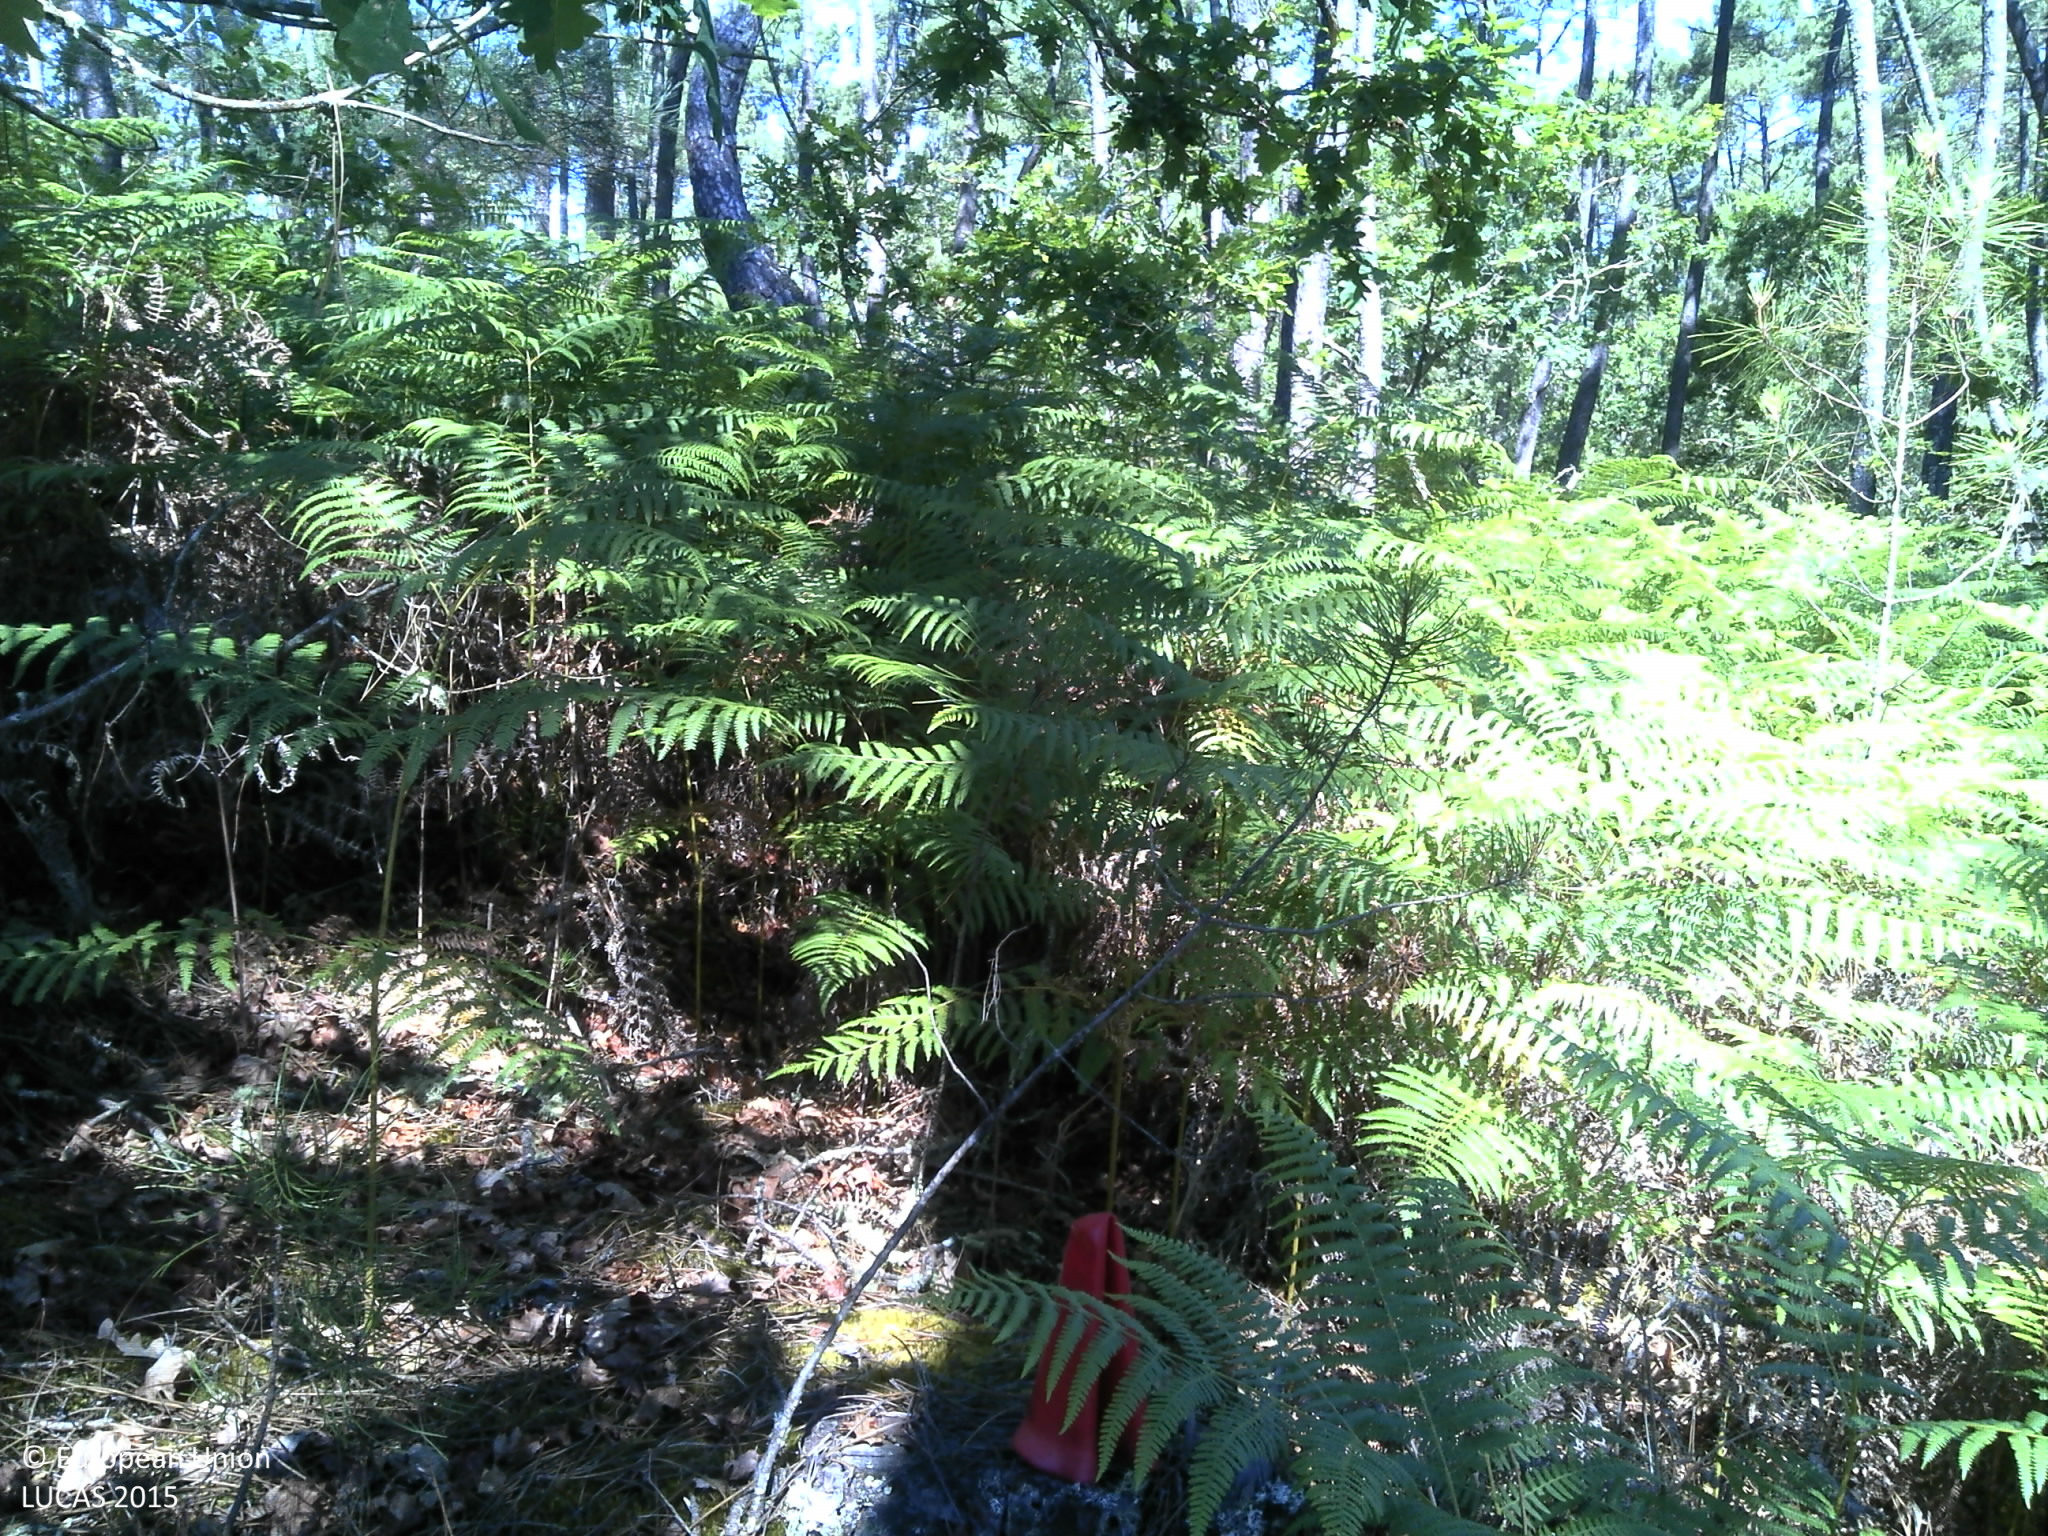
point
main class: Woodland
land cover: Pine dominated coniferous woodland
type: coniferous forest of the mediterranean region
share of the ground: > 75 %
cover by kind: coniferous forest trees 75 %, shrubs 15 %, unconsolidated bare surface 10 %
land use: Forestry
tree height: > 5 m
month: June
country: PT
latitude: 40.6875
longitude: -8.0311
